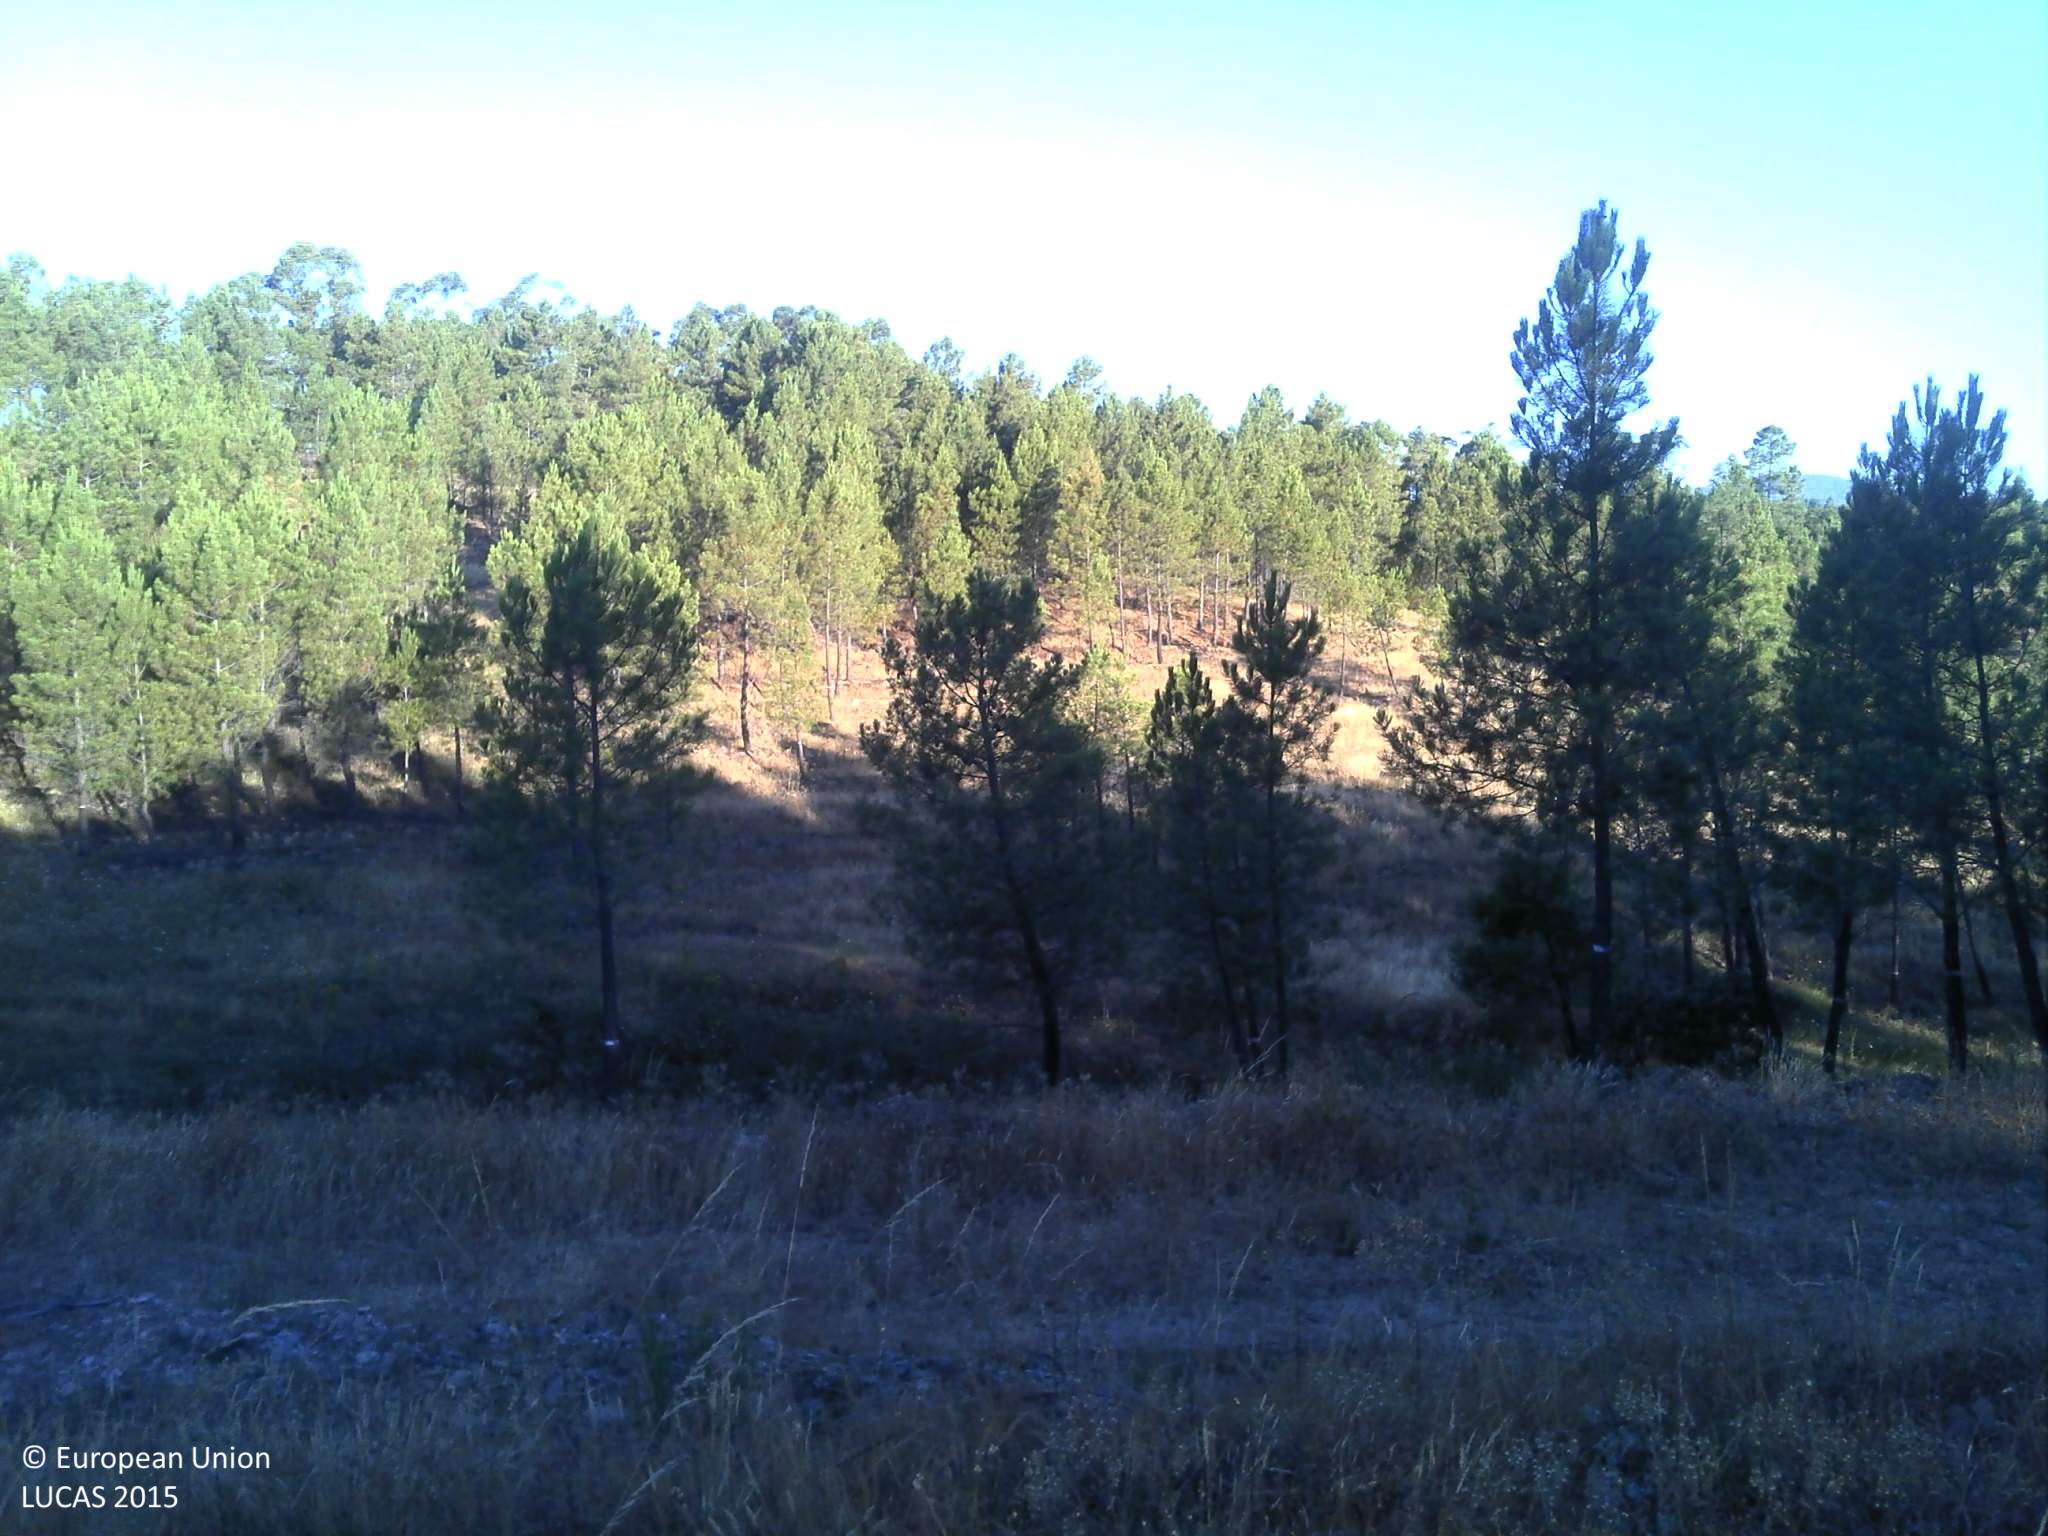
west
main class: Woodland
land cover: Pine dominated coniferous woodland
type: coniferous forest of the mediterranean region
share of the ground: 10 - 25 %
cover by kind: unconsolidated bare surface 30 %, coniferous forest trees 25 %, herbaceous plants 25 %, shrubs 20 %
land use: Forestry
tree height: > 5 m
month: July
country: PT
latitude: 39.9580
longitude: -7.5808
